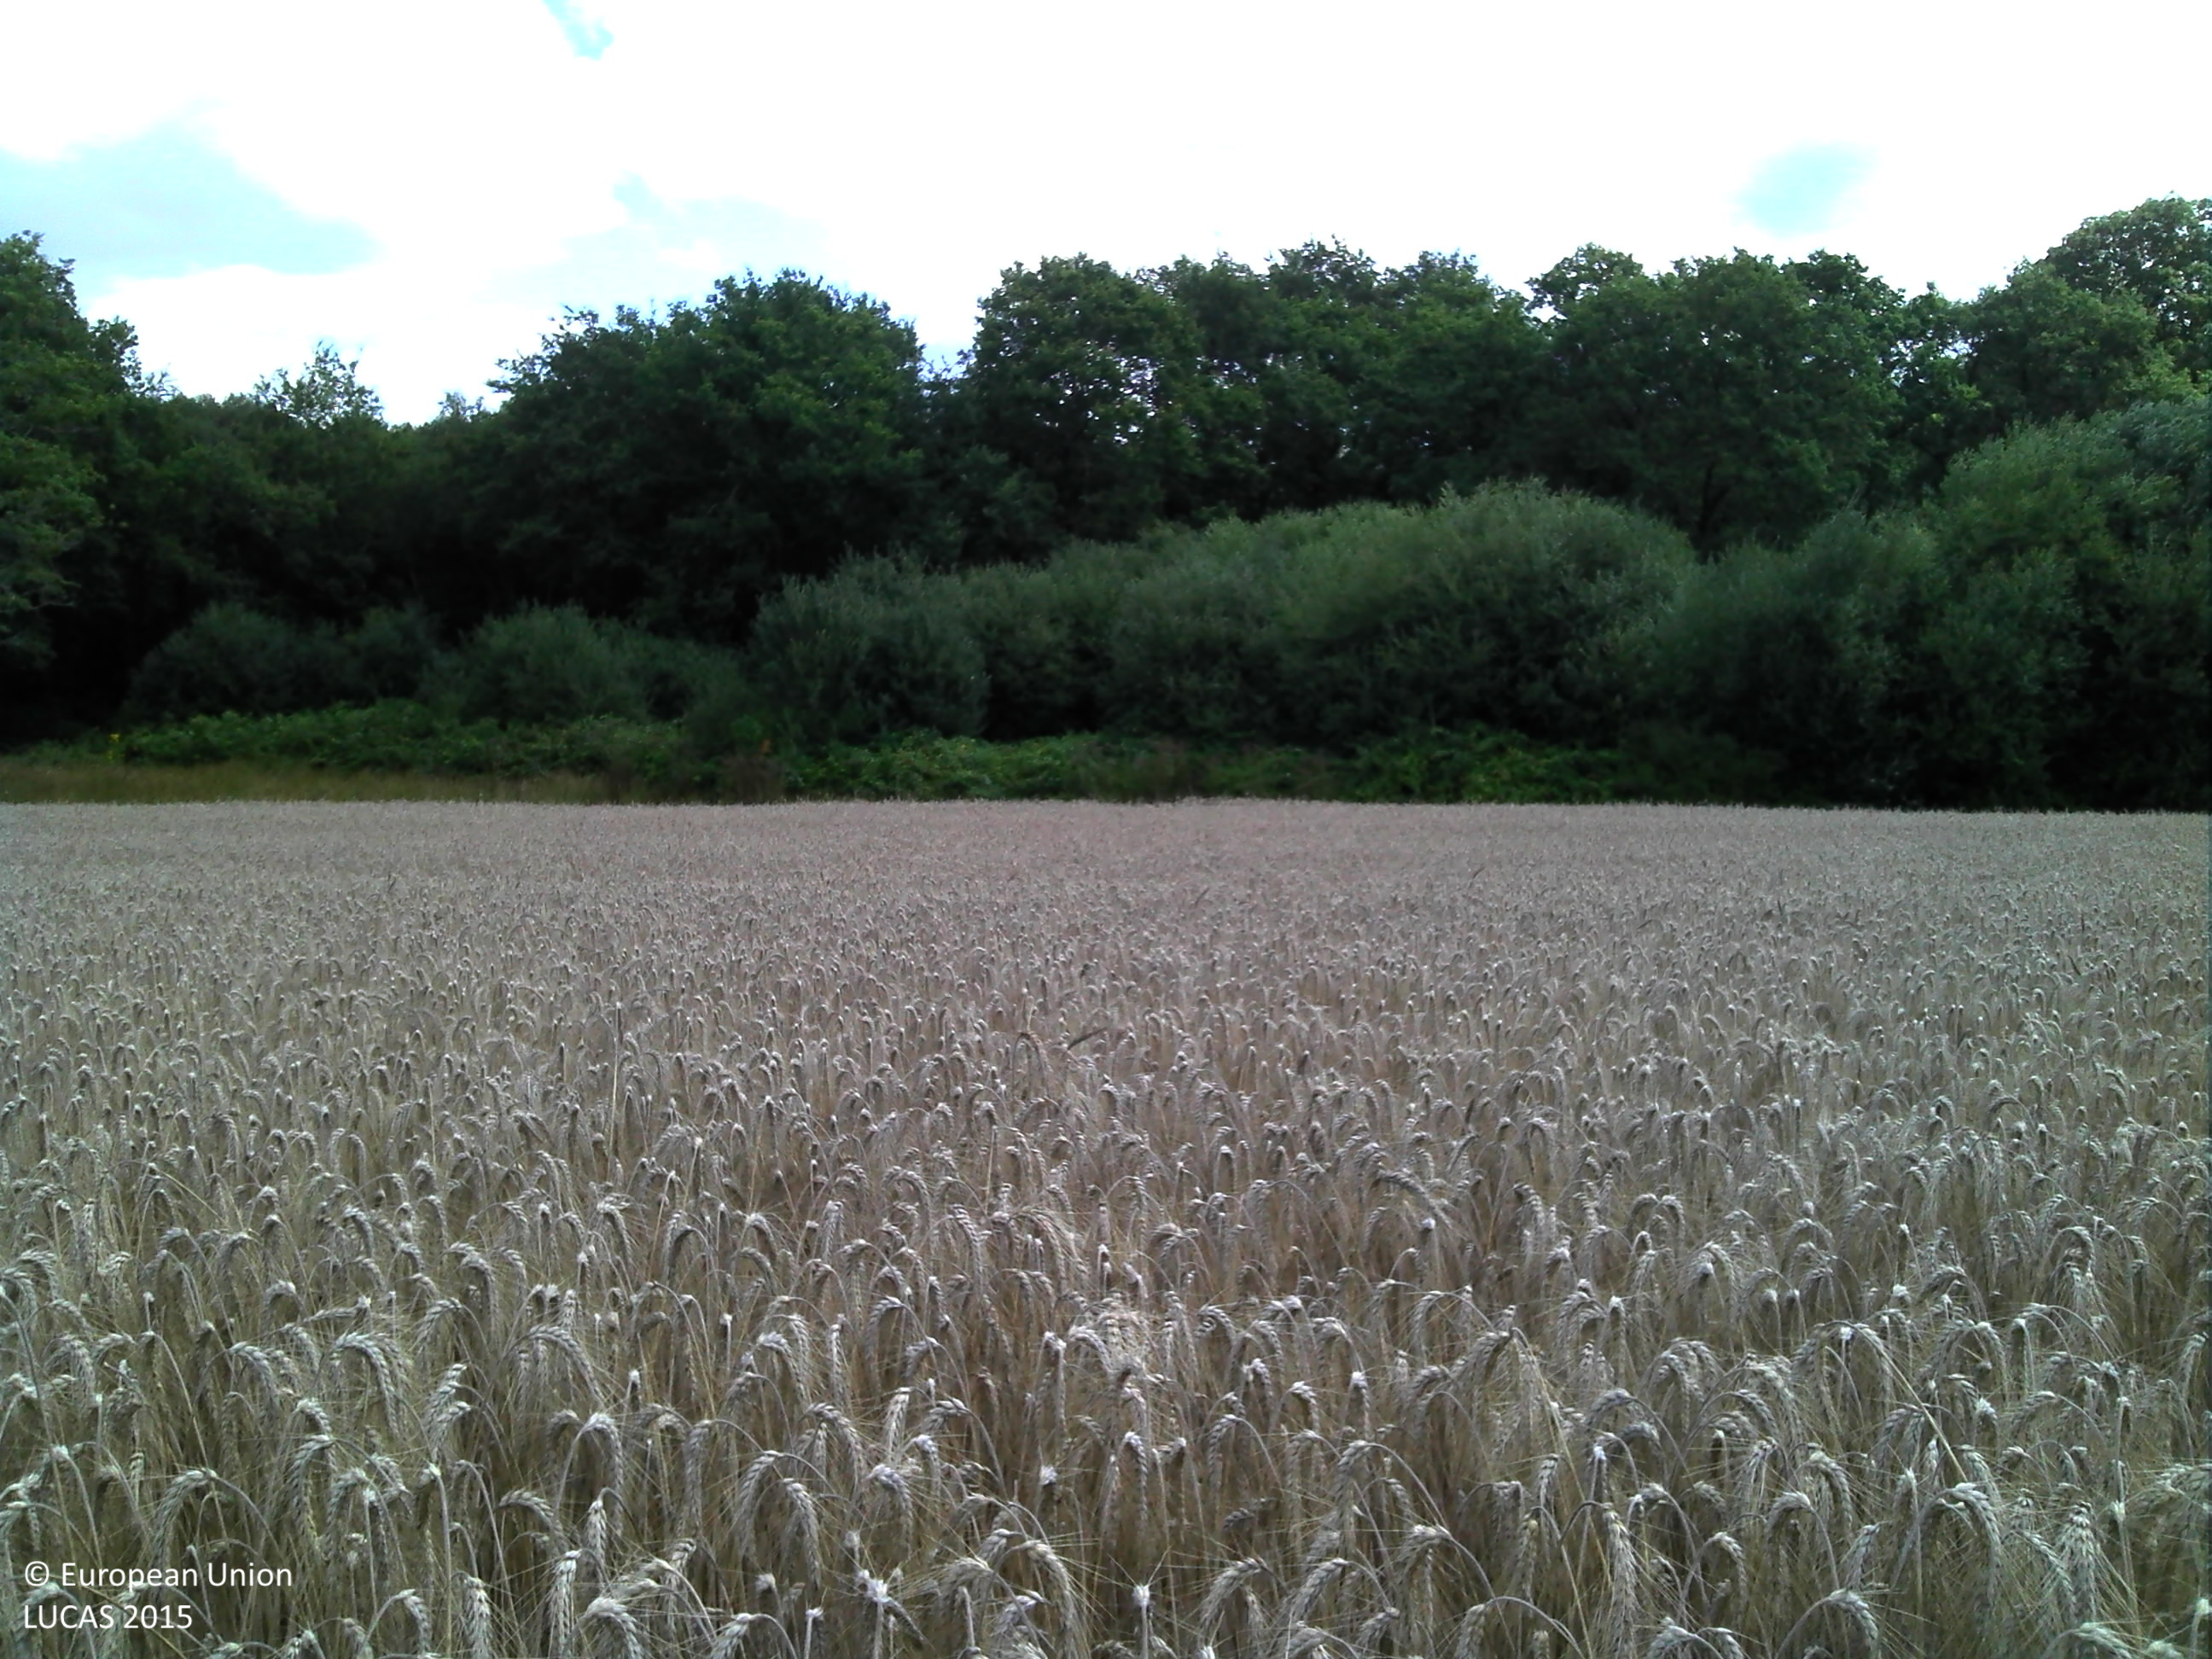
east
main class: Cropland
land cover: Common wheat
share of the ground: > 75 %
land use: Agriculture (excluding fallow land and kitchen gardens)
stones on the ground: < 10 %
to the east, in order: Common wheat; Spontaneously vegetated surfaces; Shrubland with sparse tree cover; Broadleaved woodland; Rivers and streams; Broadleaved woodland; Artificial constructions in urban areas; Lines of trees
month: July
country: FR
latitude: 47.7521
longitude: -2.9104
